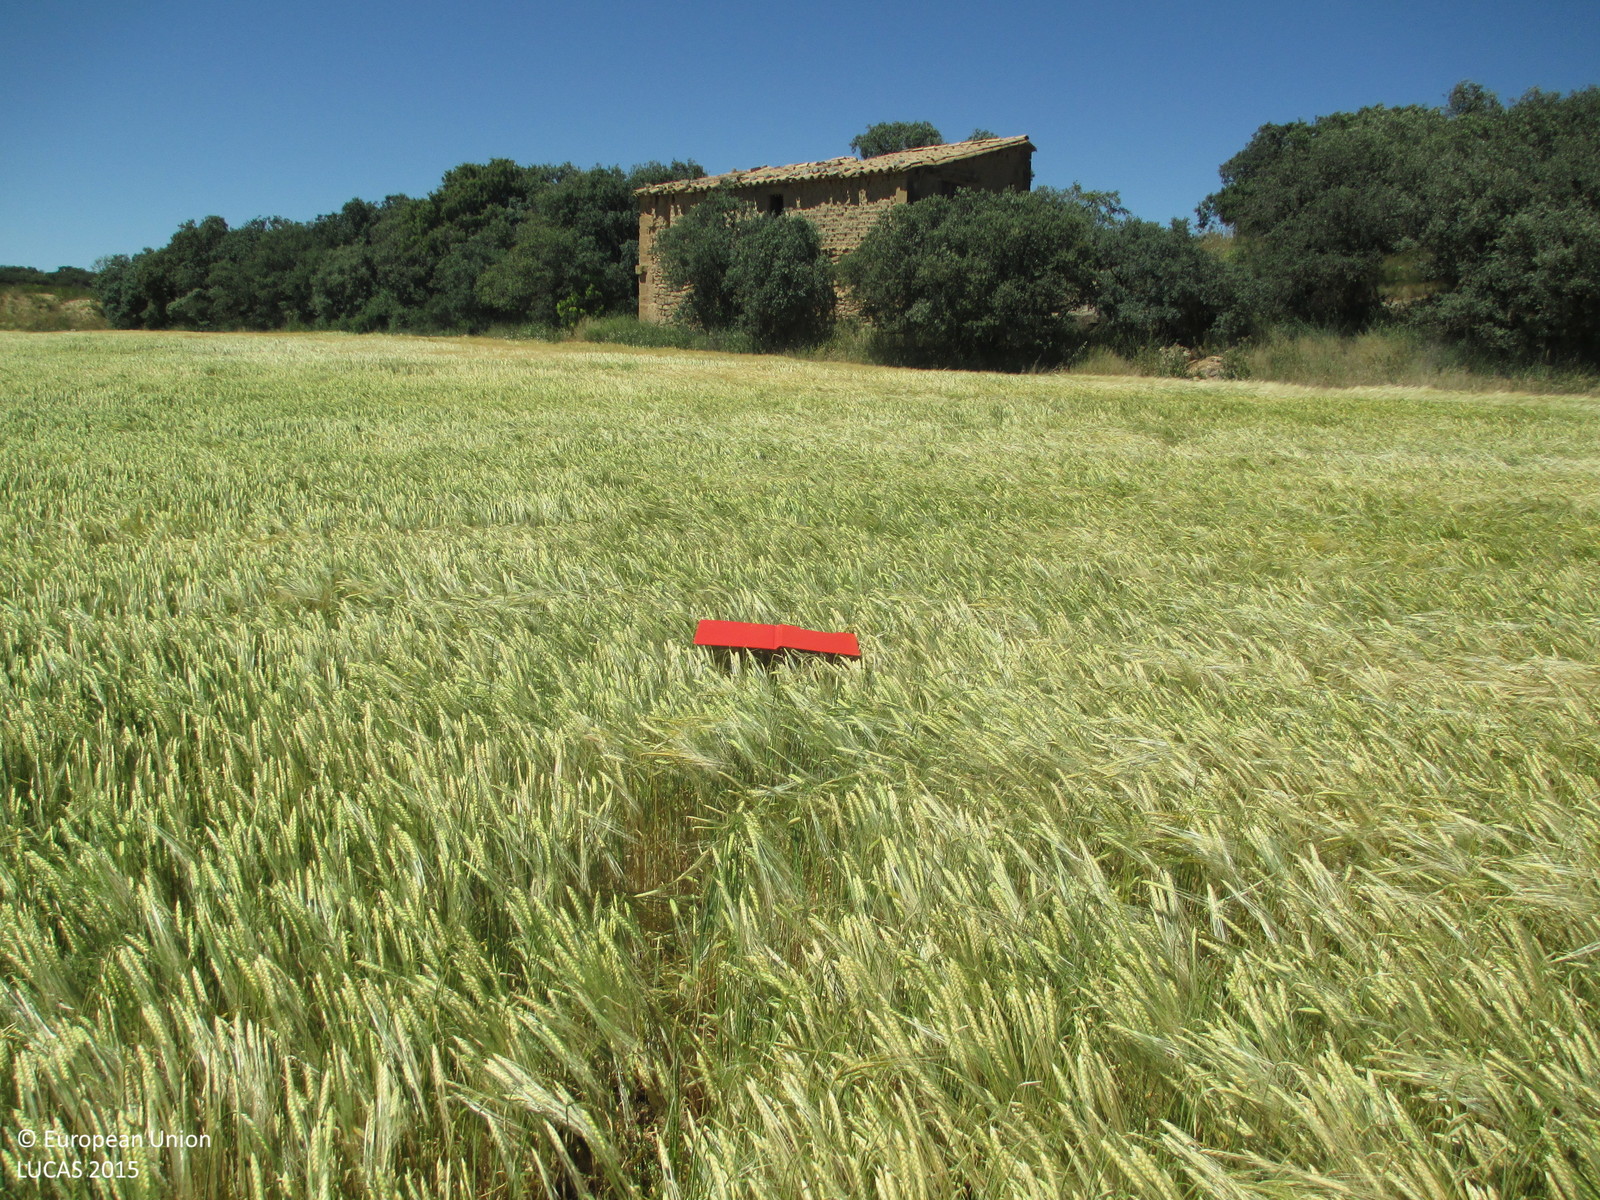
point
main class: Cropland
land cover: Barley
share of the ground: > 75 %
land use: Agriculture (excluding fallow land and kitchen gardens)
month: May
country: ES
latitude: 42.0284
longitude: -0.2021
